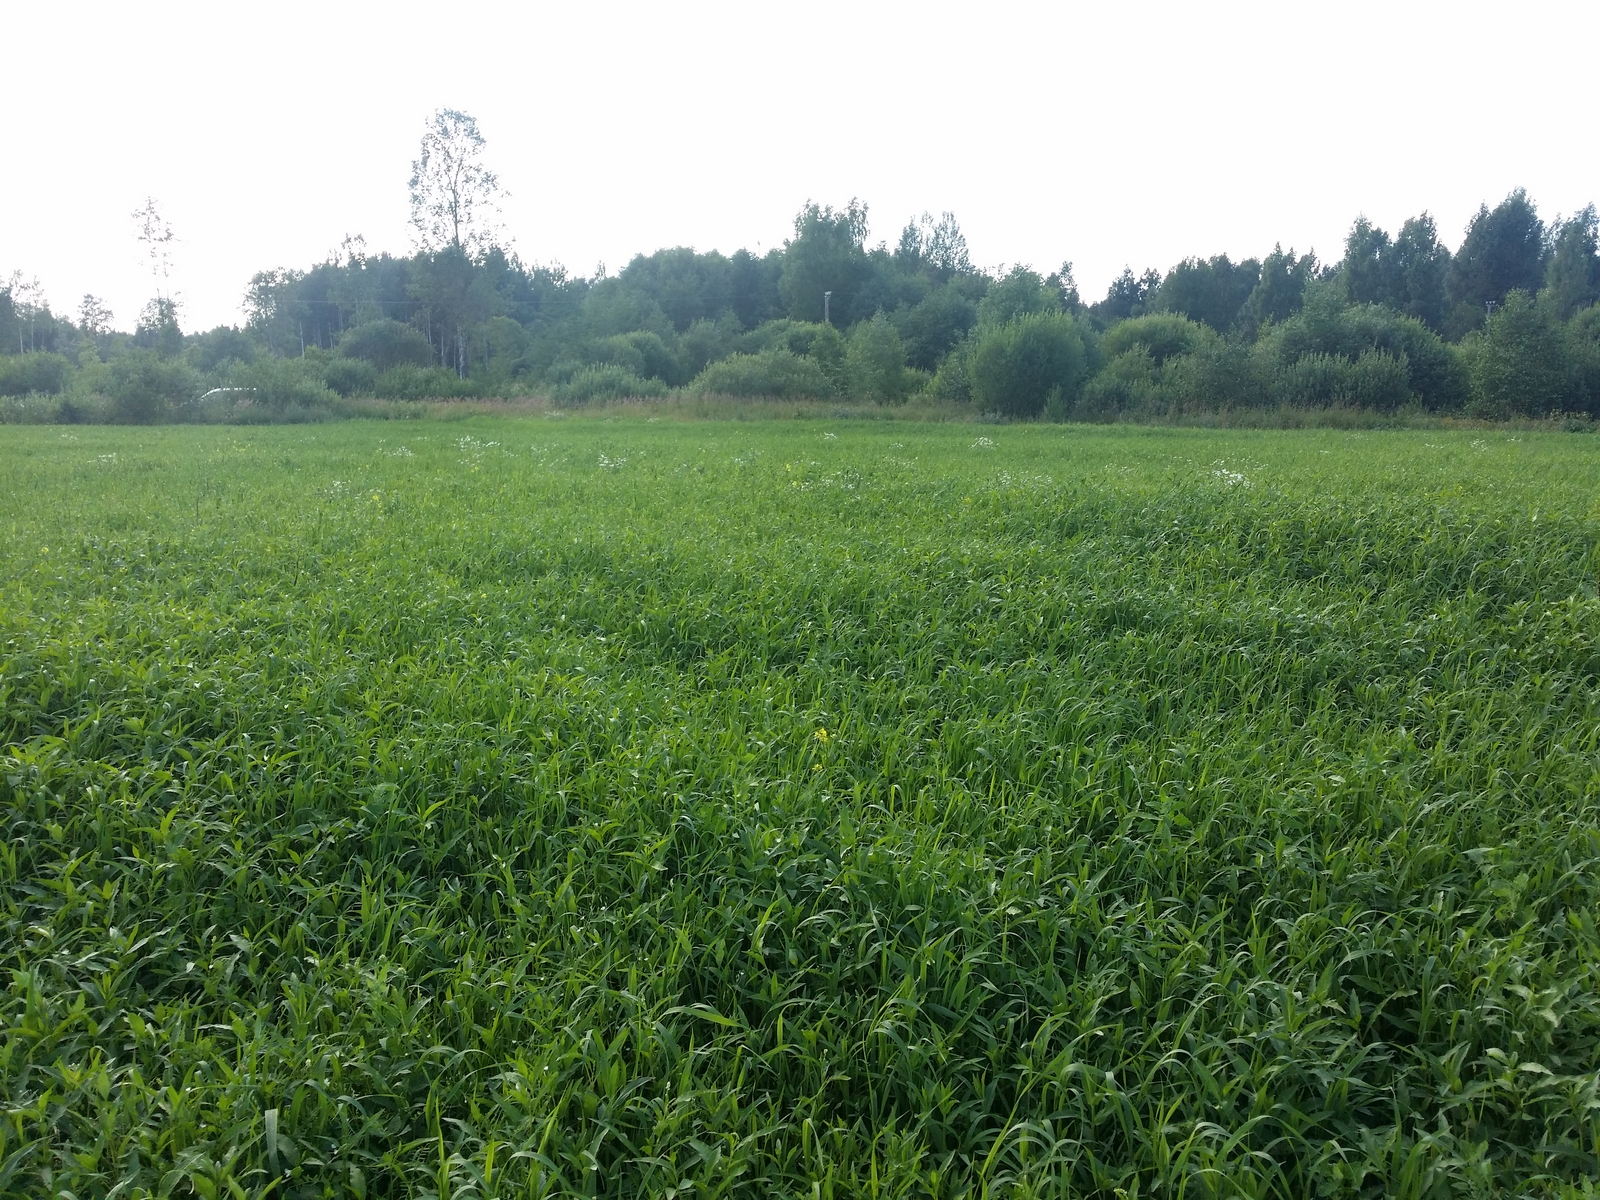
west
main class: Grassland
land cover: Grassland without tree/shrub cover
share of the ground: > 75 %
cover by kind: herbaceous plants 100 %
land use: Agriculture (excluding fallow land and kitchen gardens)
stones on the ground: < 10 %
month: July
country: LV
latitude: 57.2209
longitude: 27.2414
